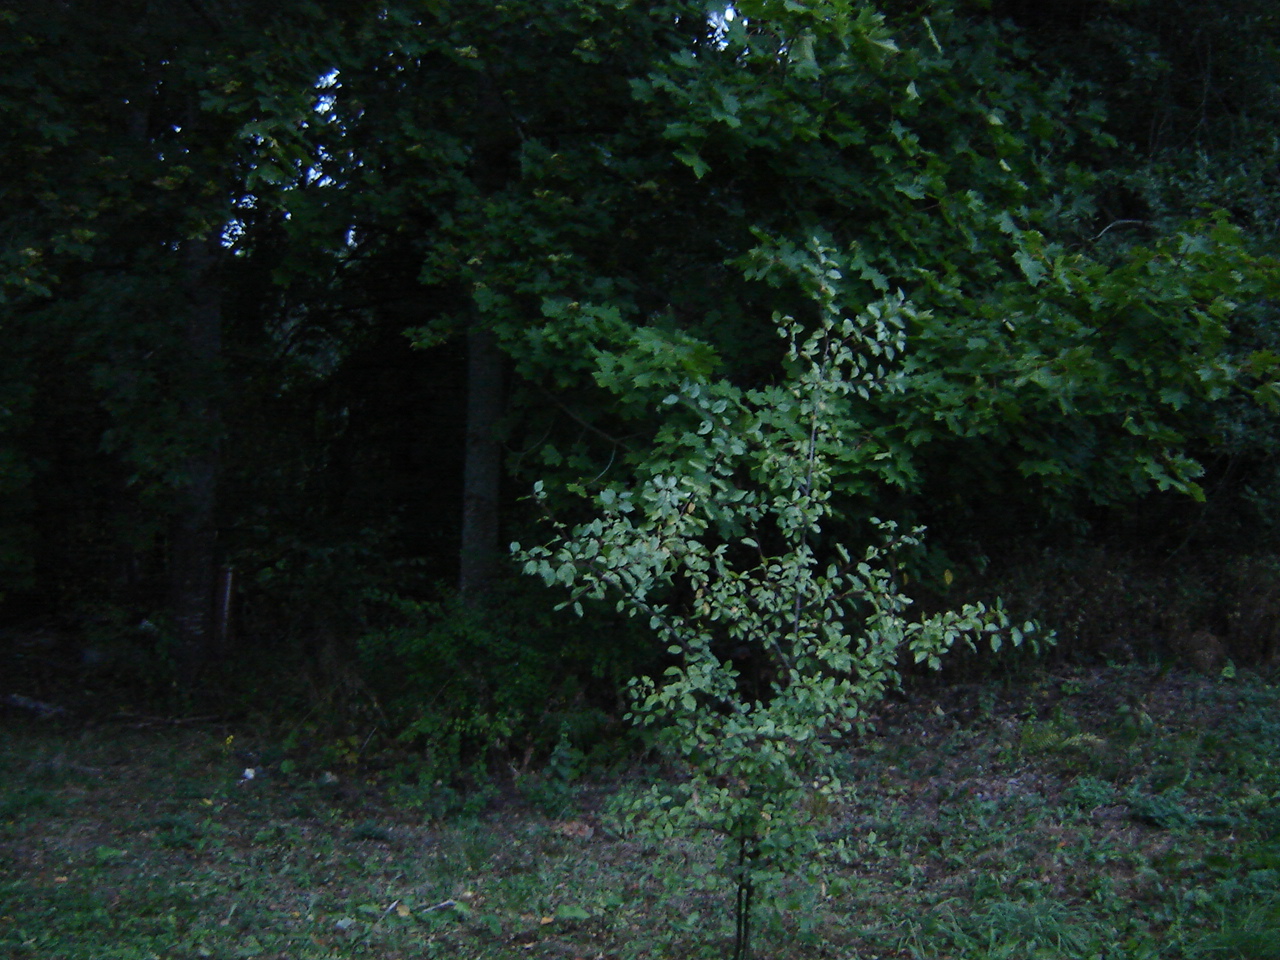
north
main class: Cropland
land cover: Apple fruit
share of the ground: > 75 %
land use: Kitchen garden
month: September
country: LT
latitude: 54.2852
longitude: 24.7482
